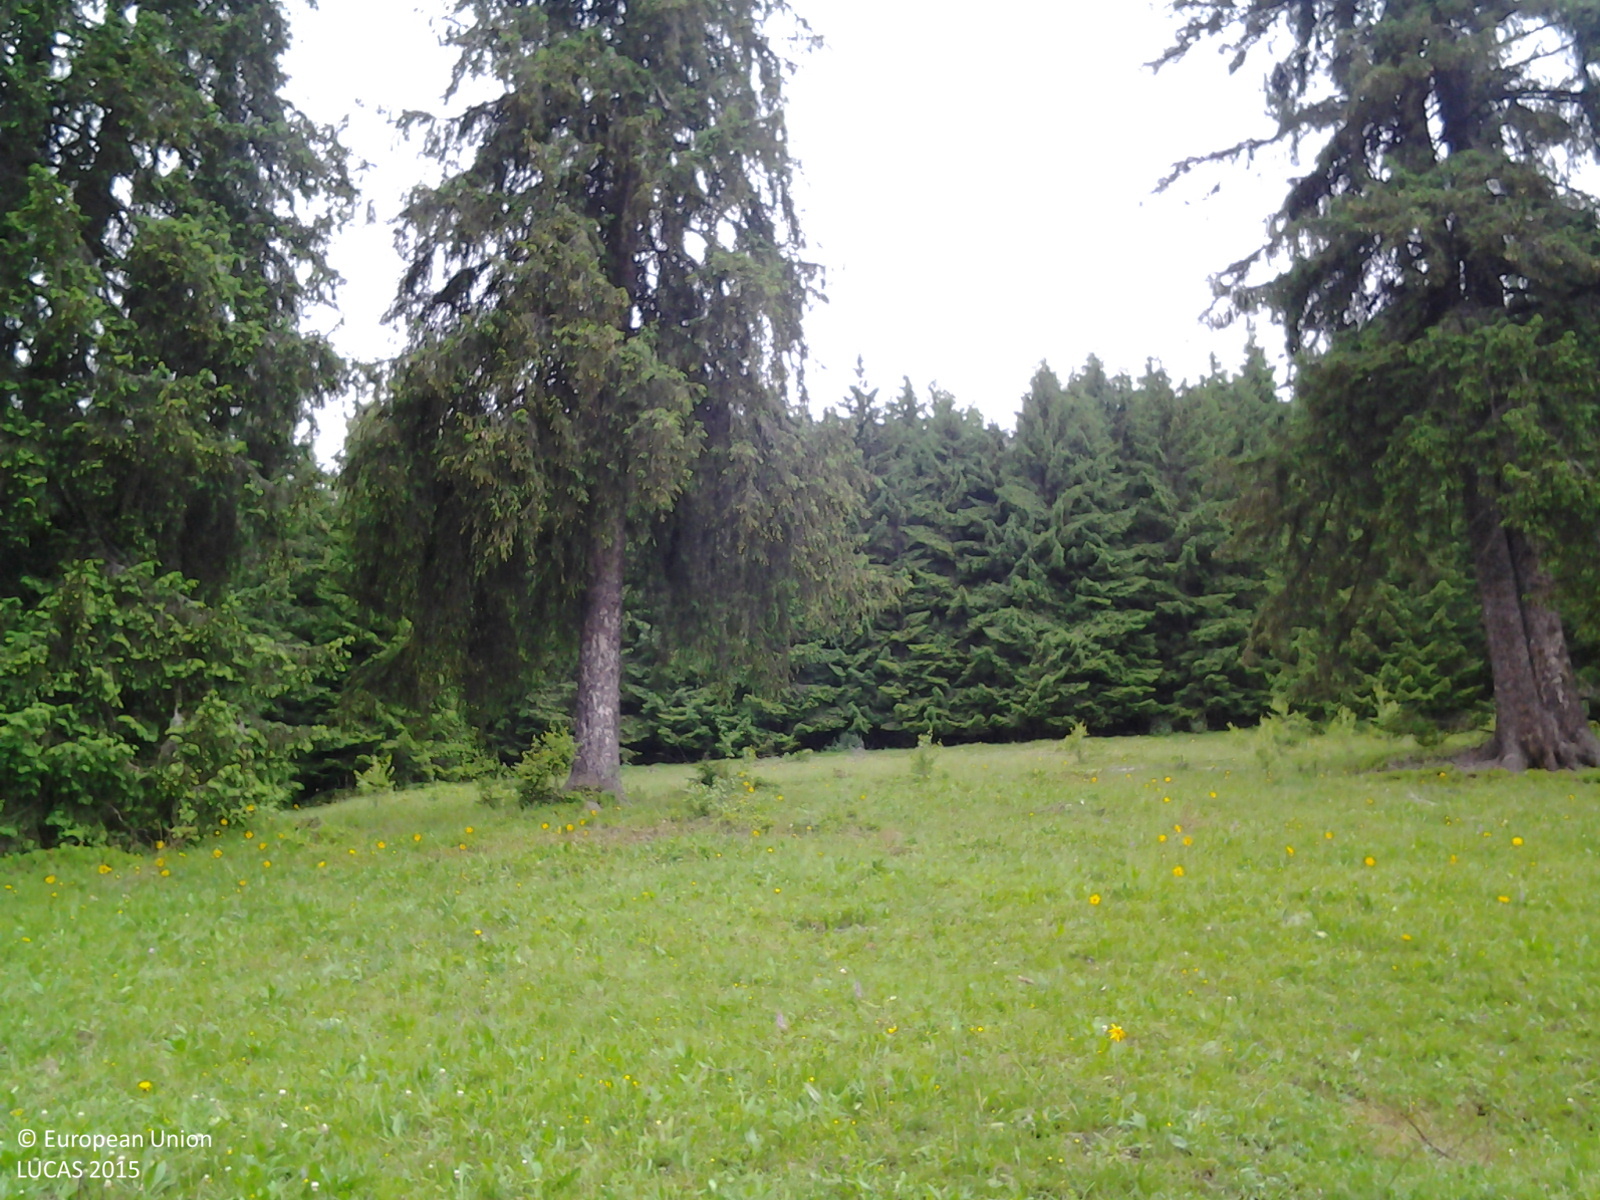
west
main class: Grassland
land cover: Grassland with sparse tree/shrub cover
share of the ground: > 75 %
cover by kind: herbaceous plants 85 %, shrubs 10 %, coniferous forest trees 5 %
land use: Agriculture (excluding fallow land and kitchen gardens)
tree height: > 5 m
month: June
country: RO
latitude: 47.7553
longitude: 25.1433
